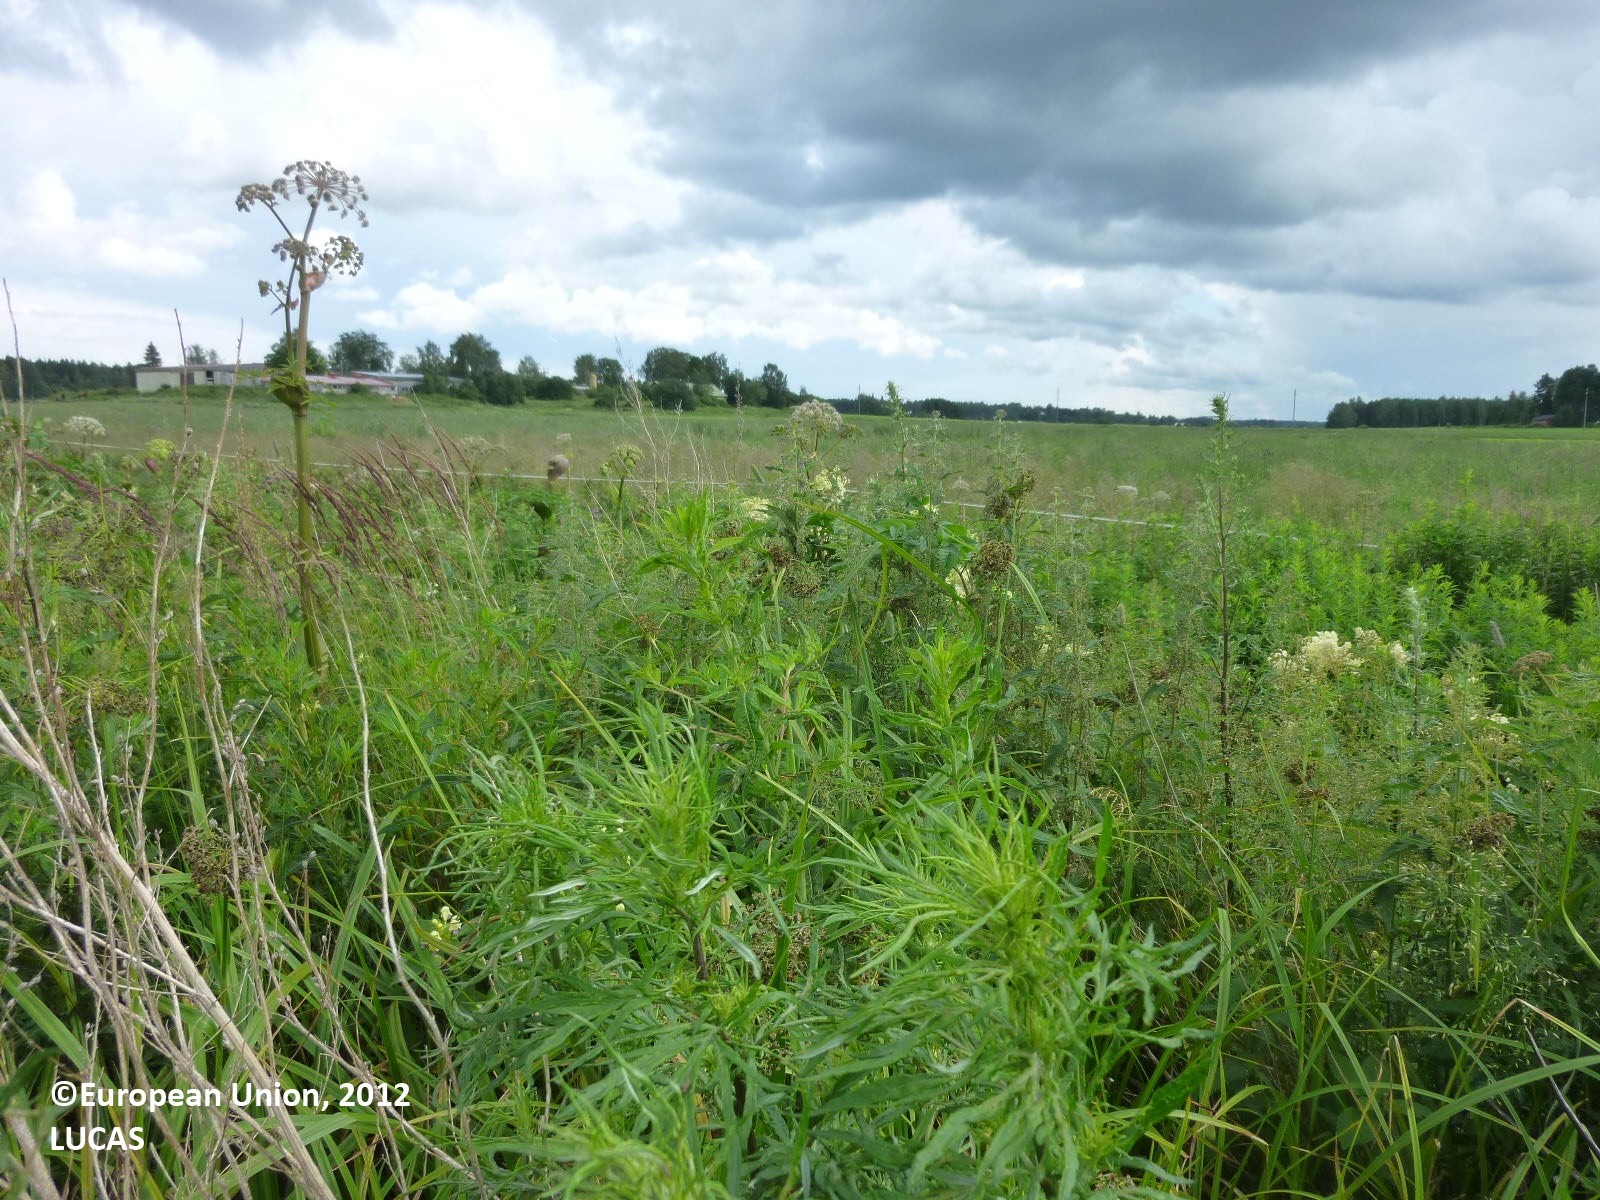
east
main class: Cropland
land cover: Oats
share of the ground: > 75 %
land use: Agriculture (excluding fallow land and kitchen gardens)
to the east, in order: Oats; Grass margins; Ditches and canals; Grass margins; Fences; Temporary grasslands
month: July
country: FI
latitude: 61.2325
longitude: 22.0361
